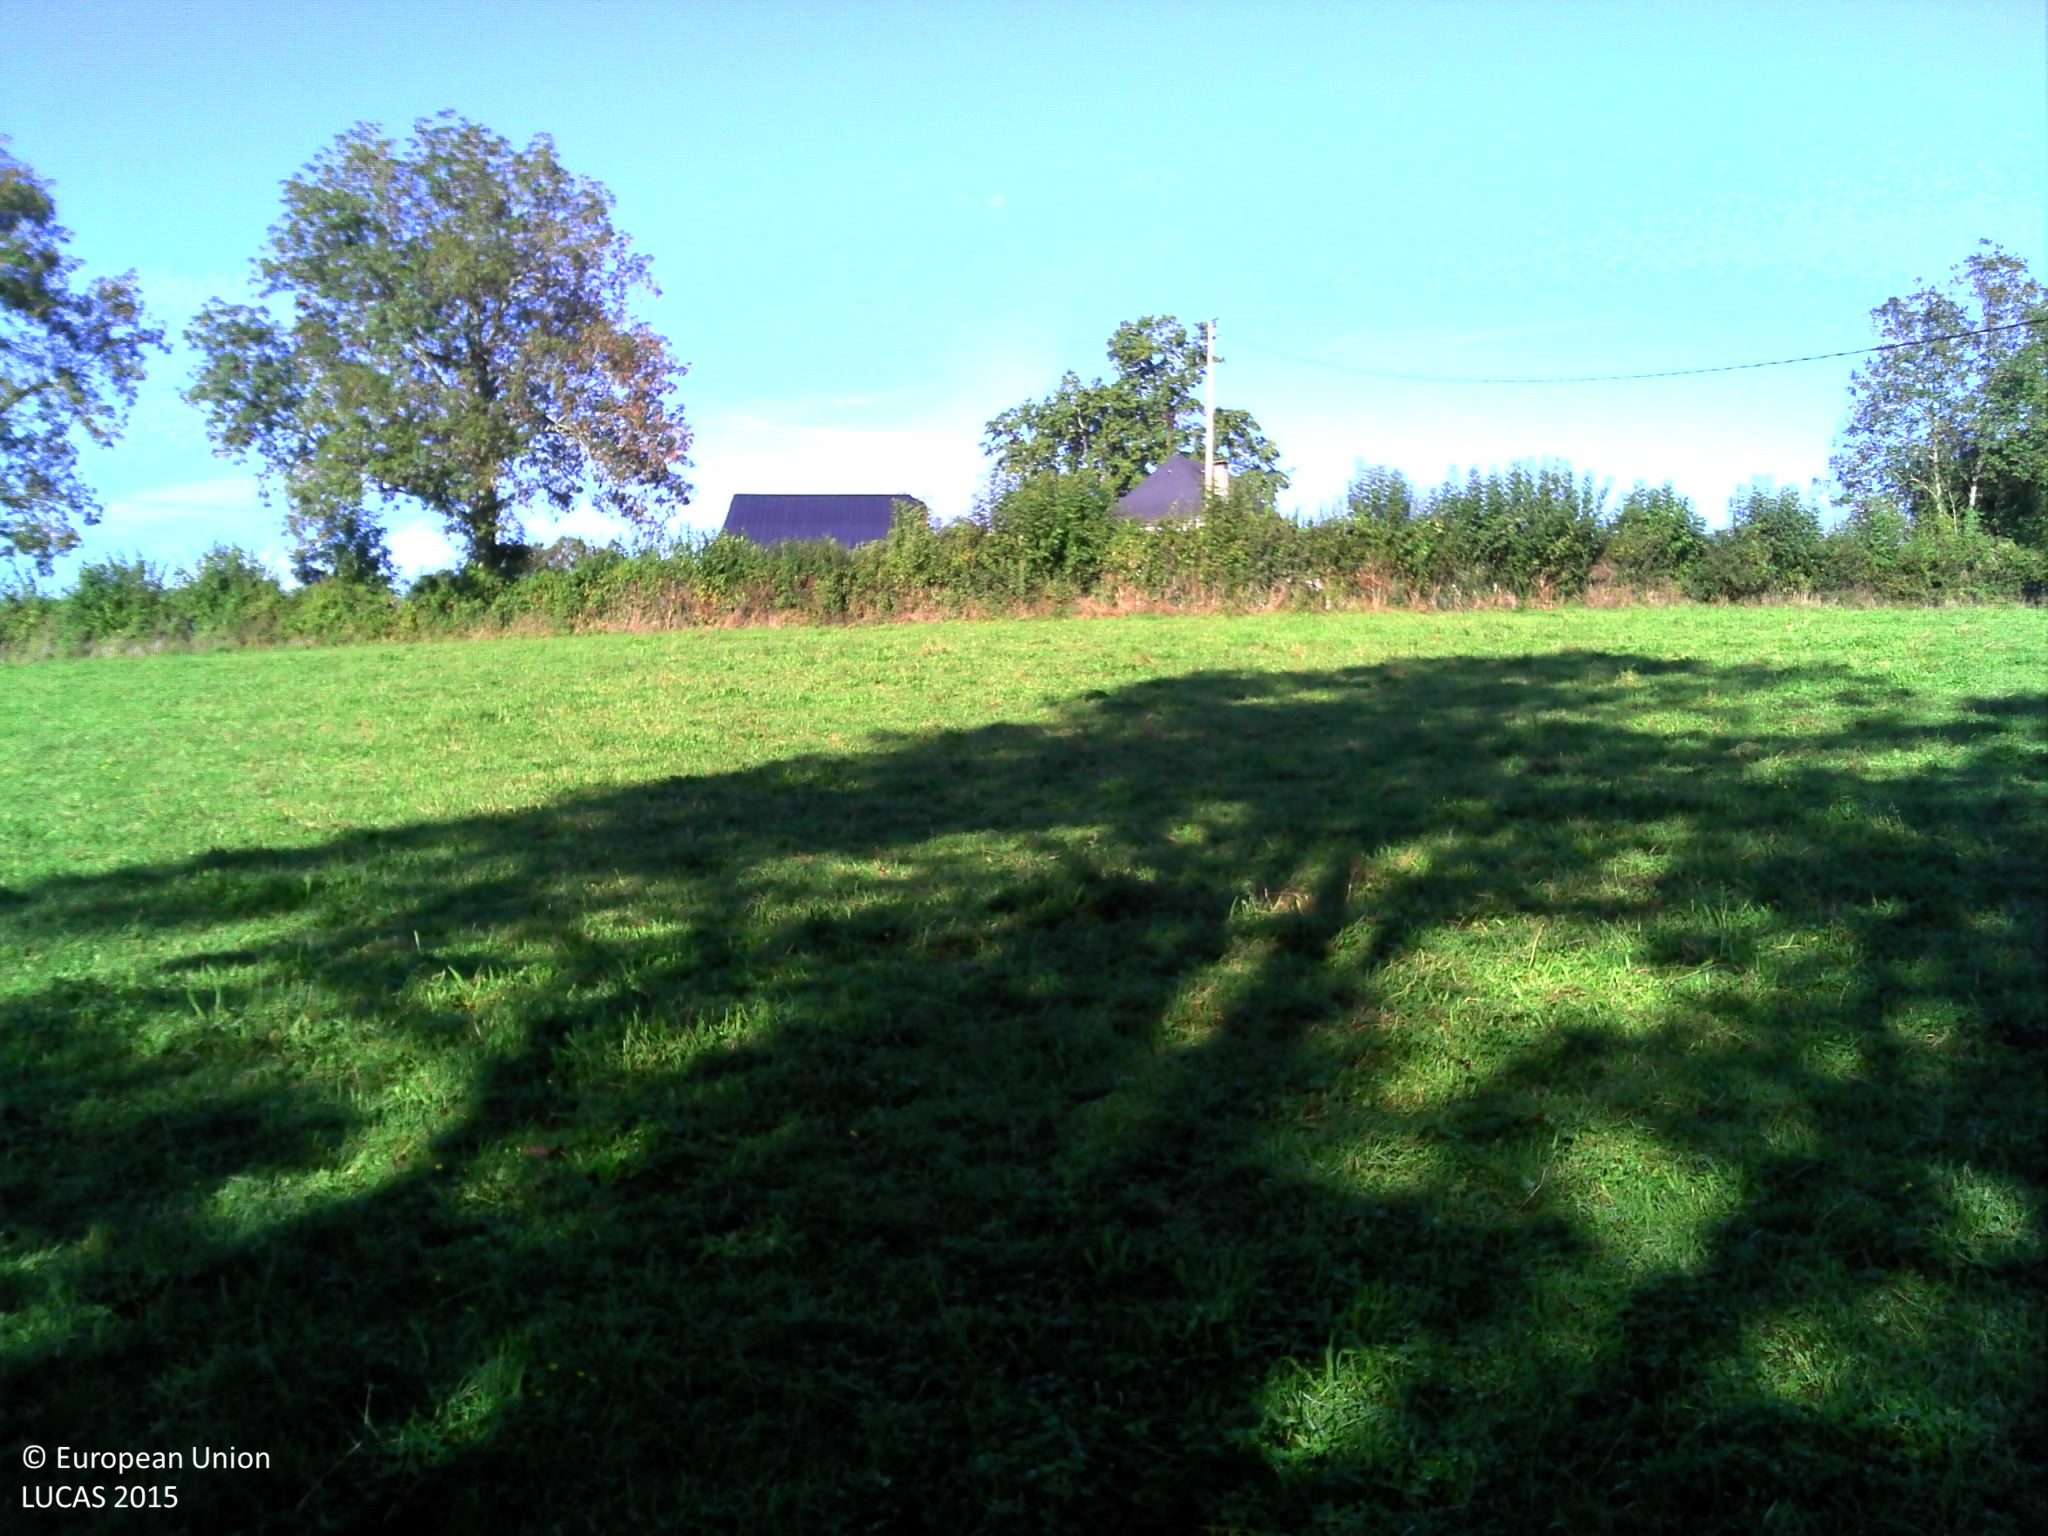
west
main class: Grassland
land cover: Grassland without tree/shrub cover
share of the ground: > 75 %
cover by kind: herbaceous plants 100 %
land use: Agriculture (excluding fallow land and kitchen gardens)
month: September
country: FR
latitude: 43.1414
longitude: -0.3455
